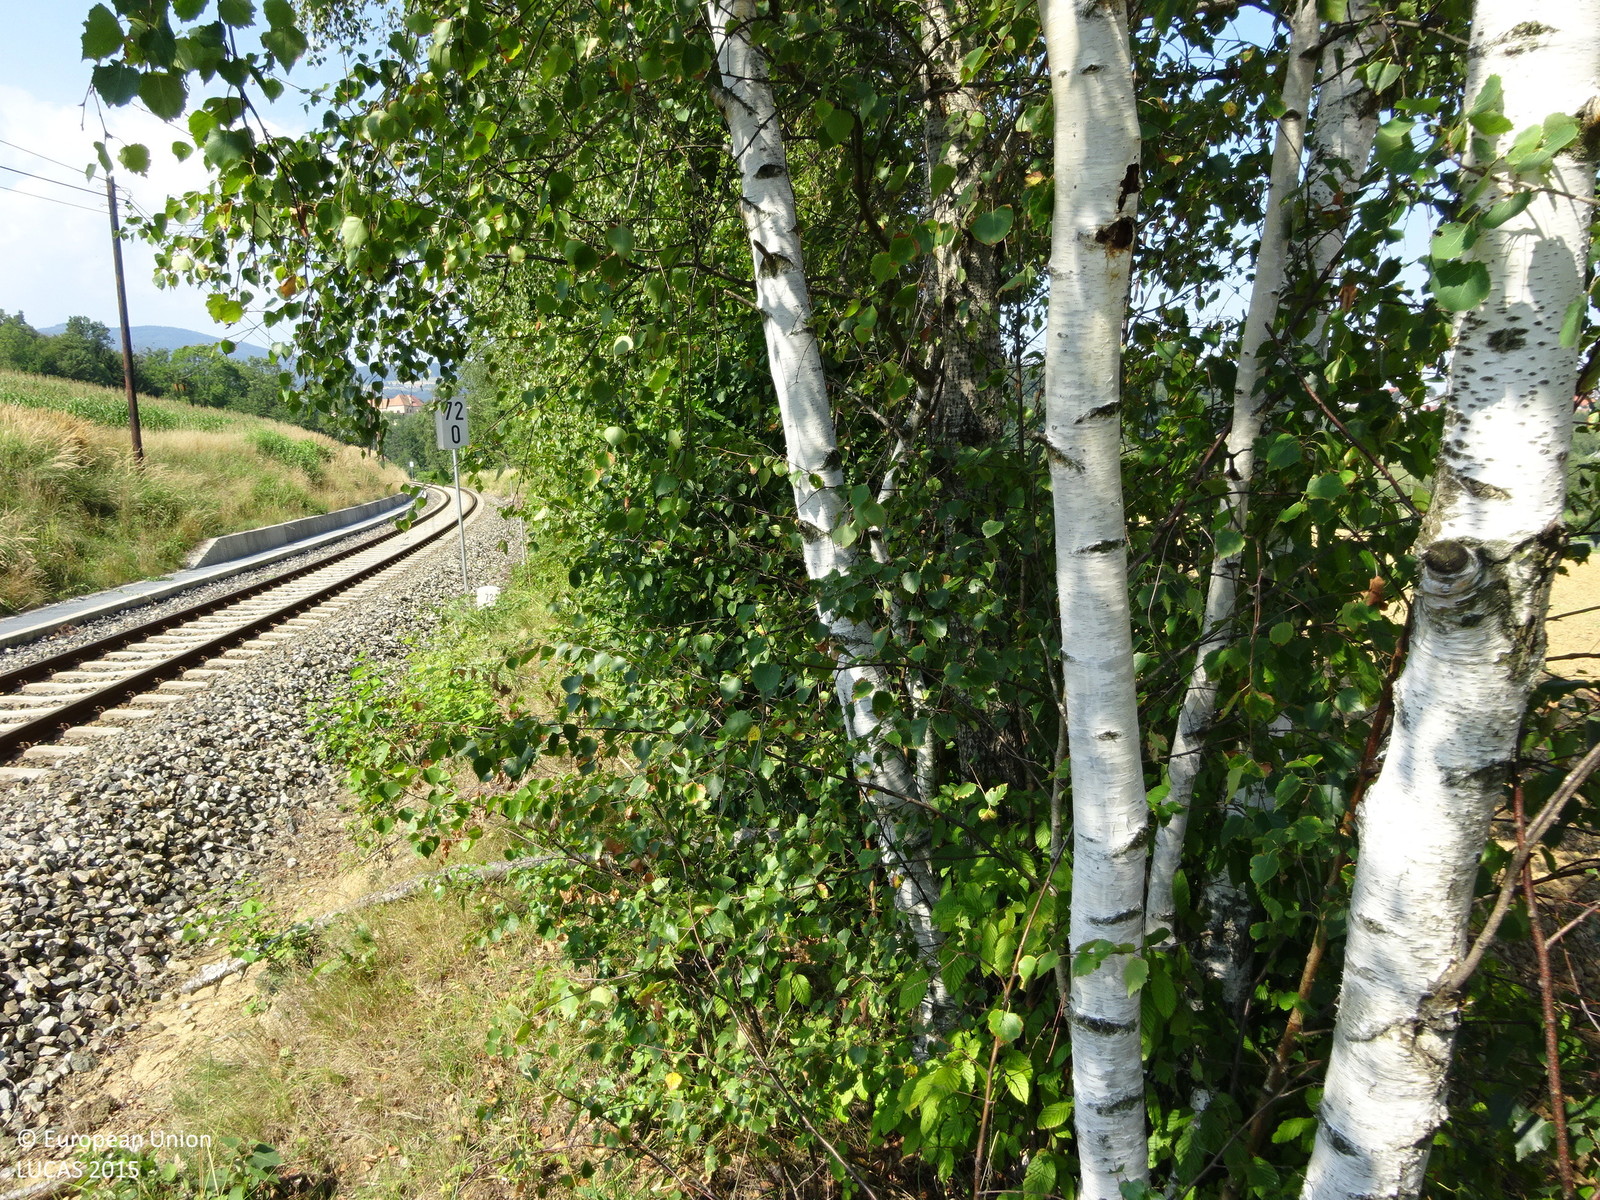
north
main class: Woodland
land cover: Broadleaved woodland
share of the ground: 10 - 25 %
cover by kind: unconsolidated bare surface 45 %, broadleaved forest trees 25 %, herbaceous plants 20 %, consolidated bare surface 10 %
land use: Forestry
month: August
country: AT
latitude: 47.4102
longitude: 16.0055
